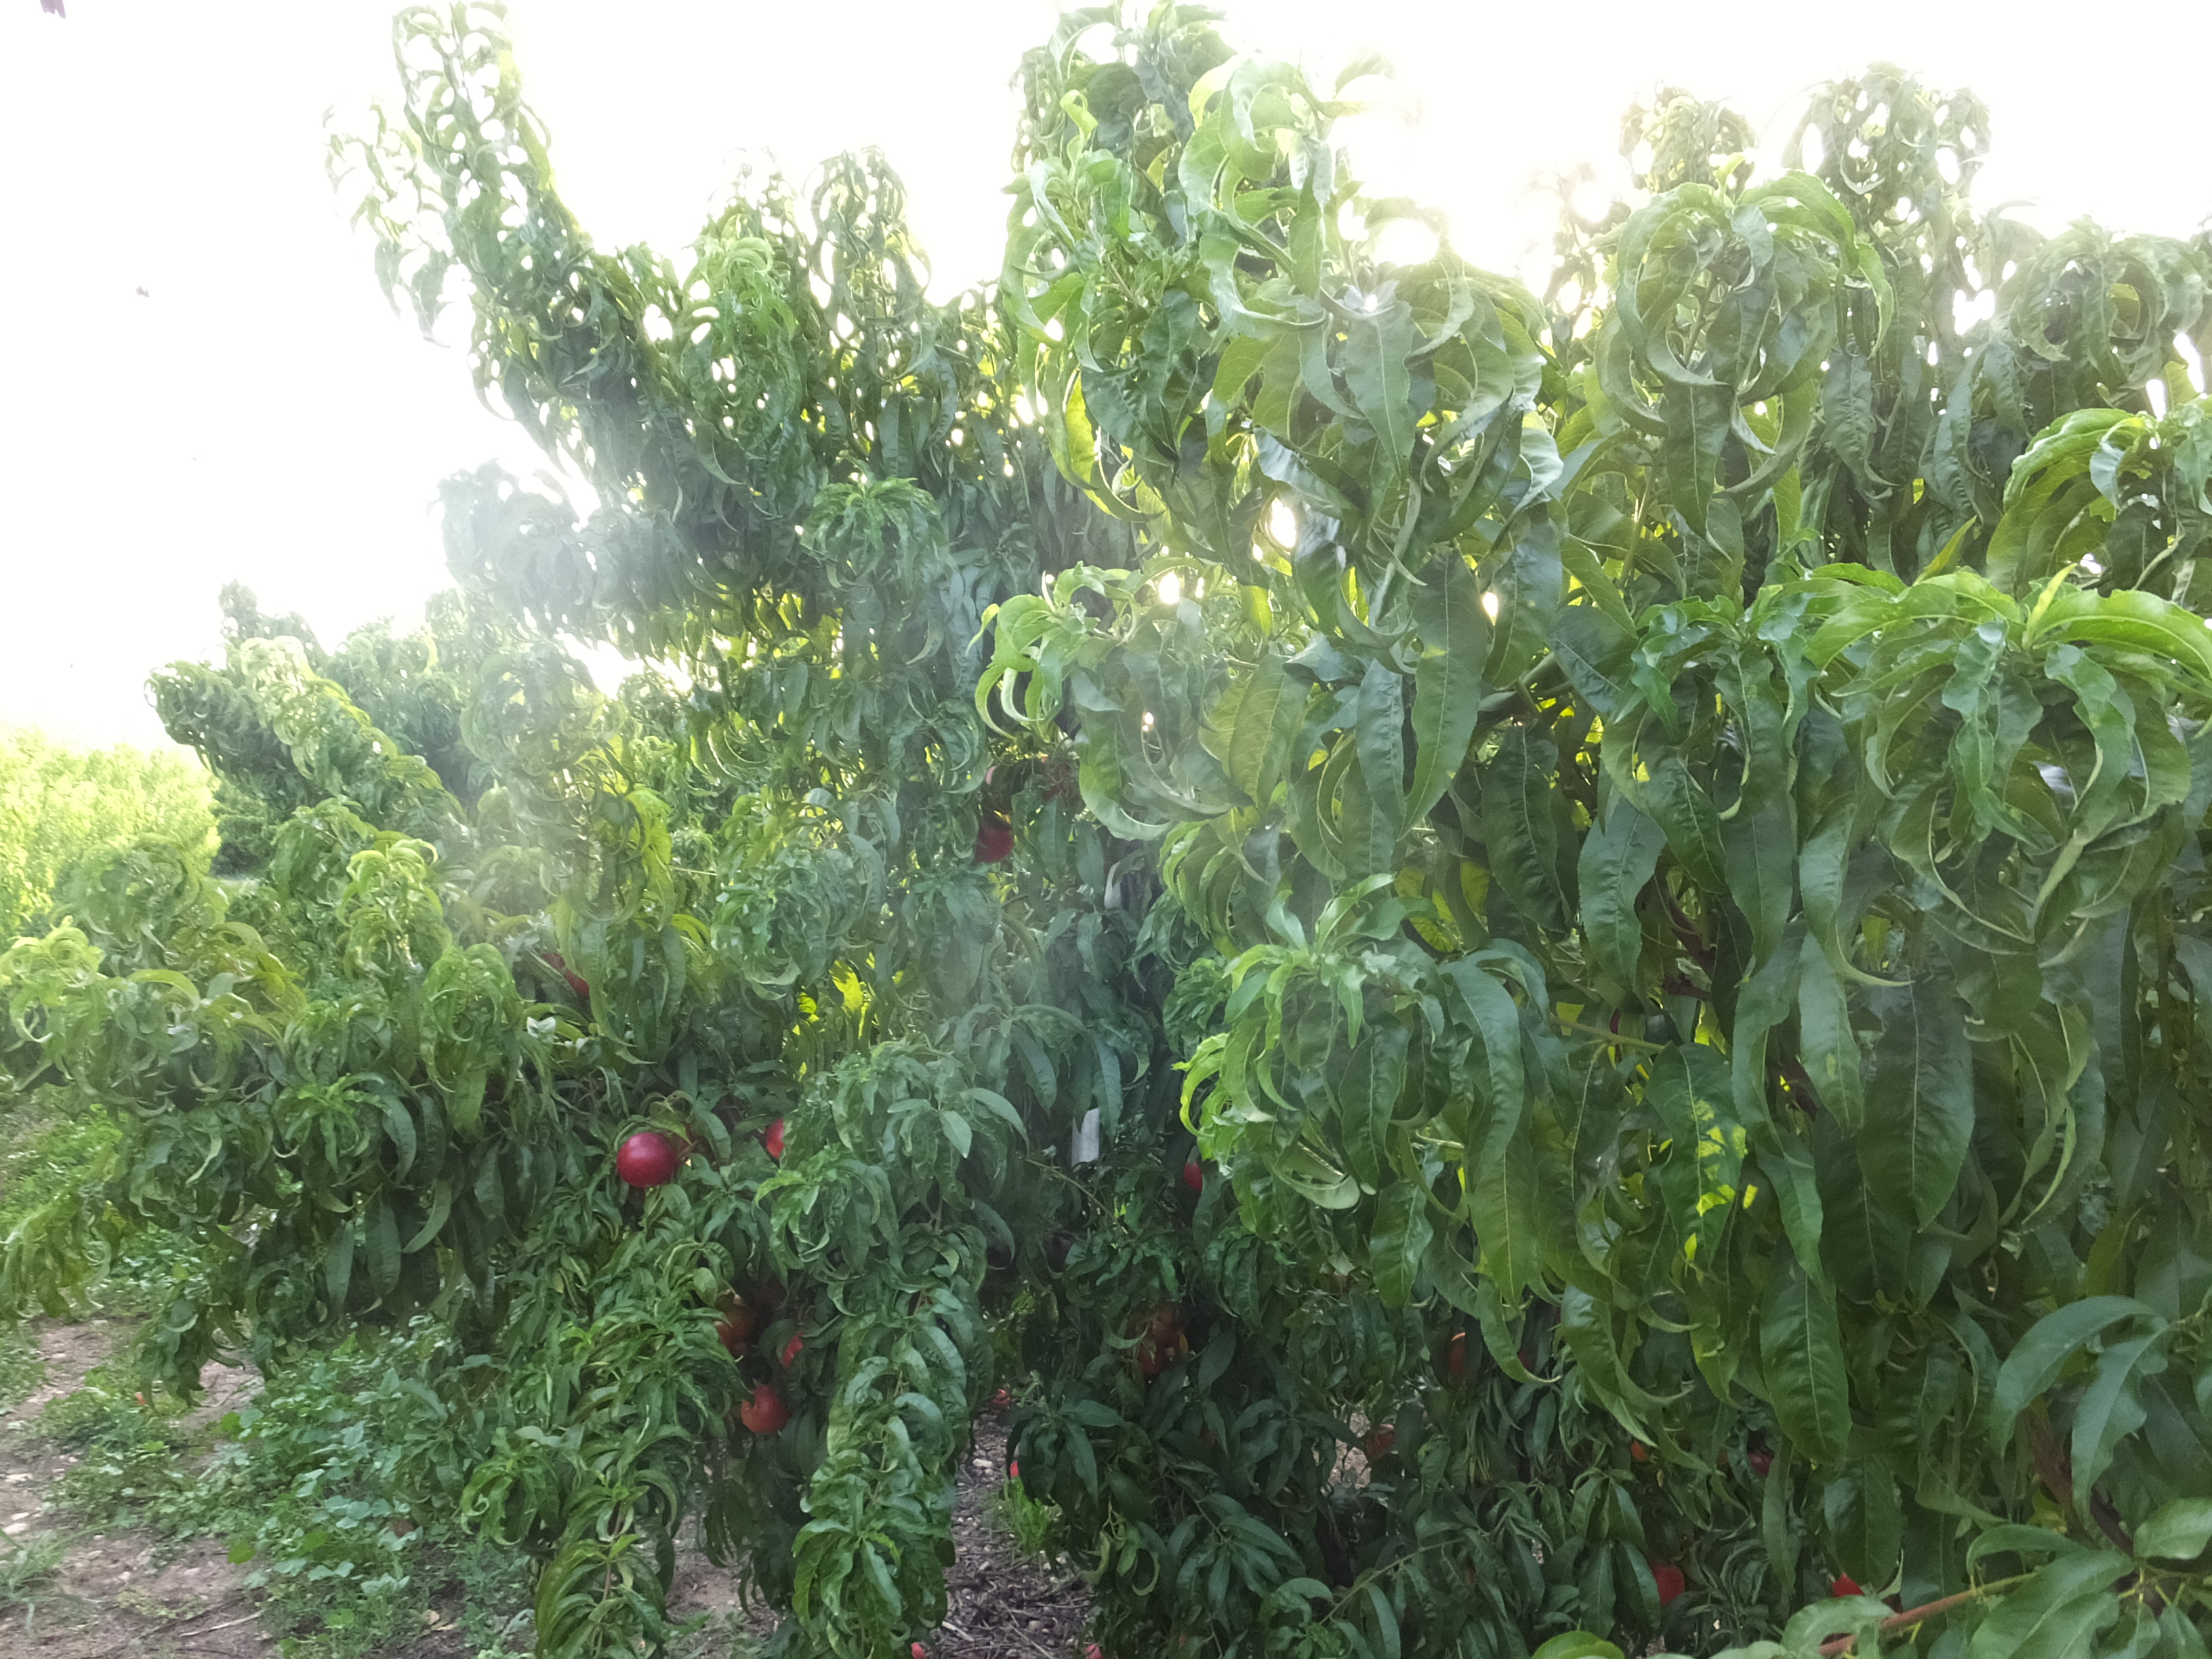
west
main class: Cropland
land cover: Other fruit trees and berries
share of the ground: > 75 %
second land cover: Spontaneously vegetated surfaces
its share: 10 - 25 %
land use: Agriculture (excluding fallow land and kitchen gardens)
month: August
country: ES
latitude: 41.5995
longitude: 0.4246
